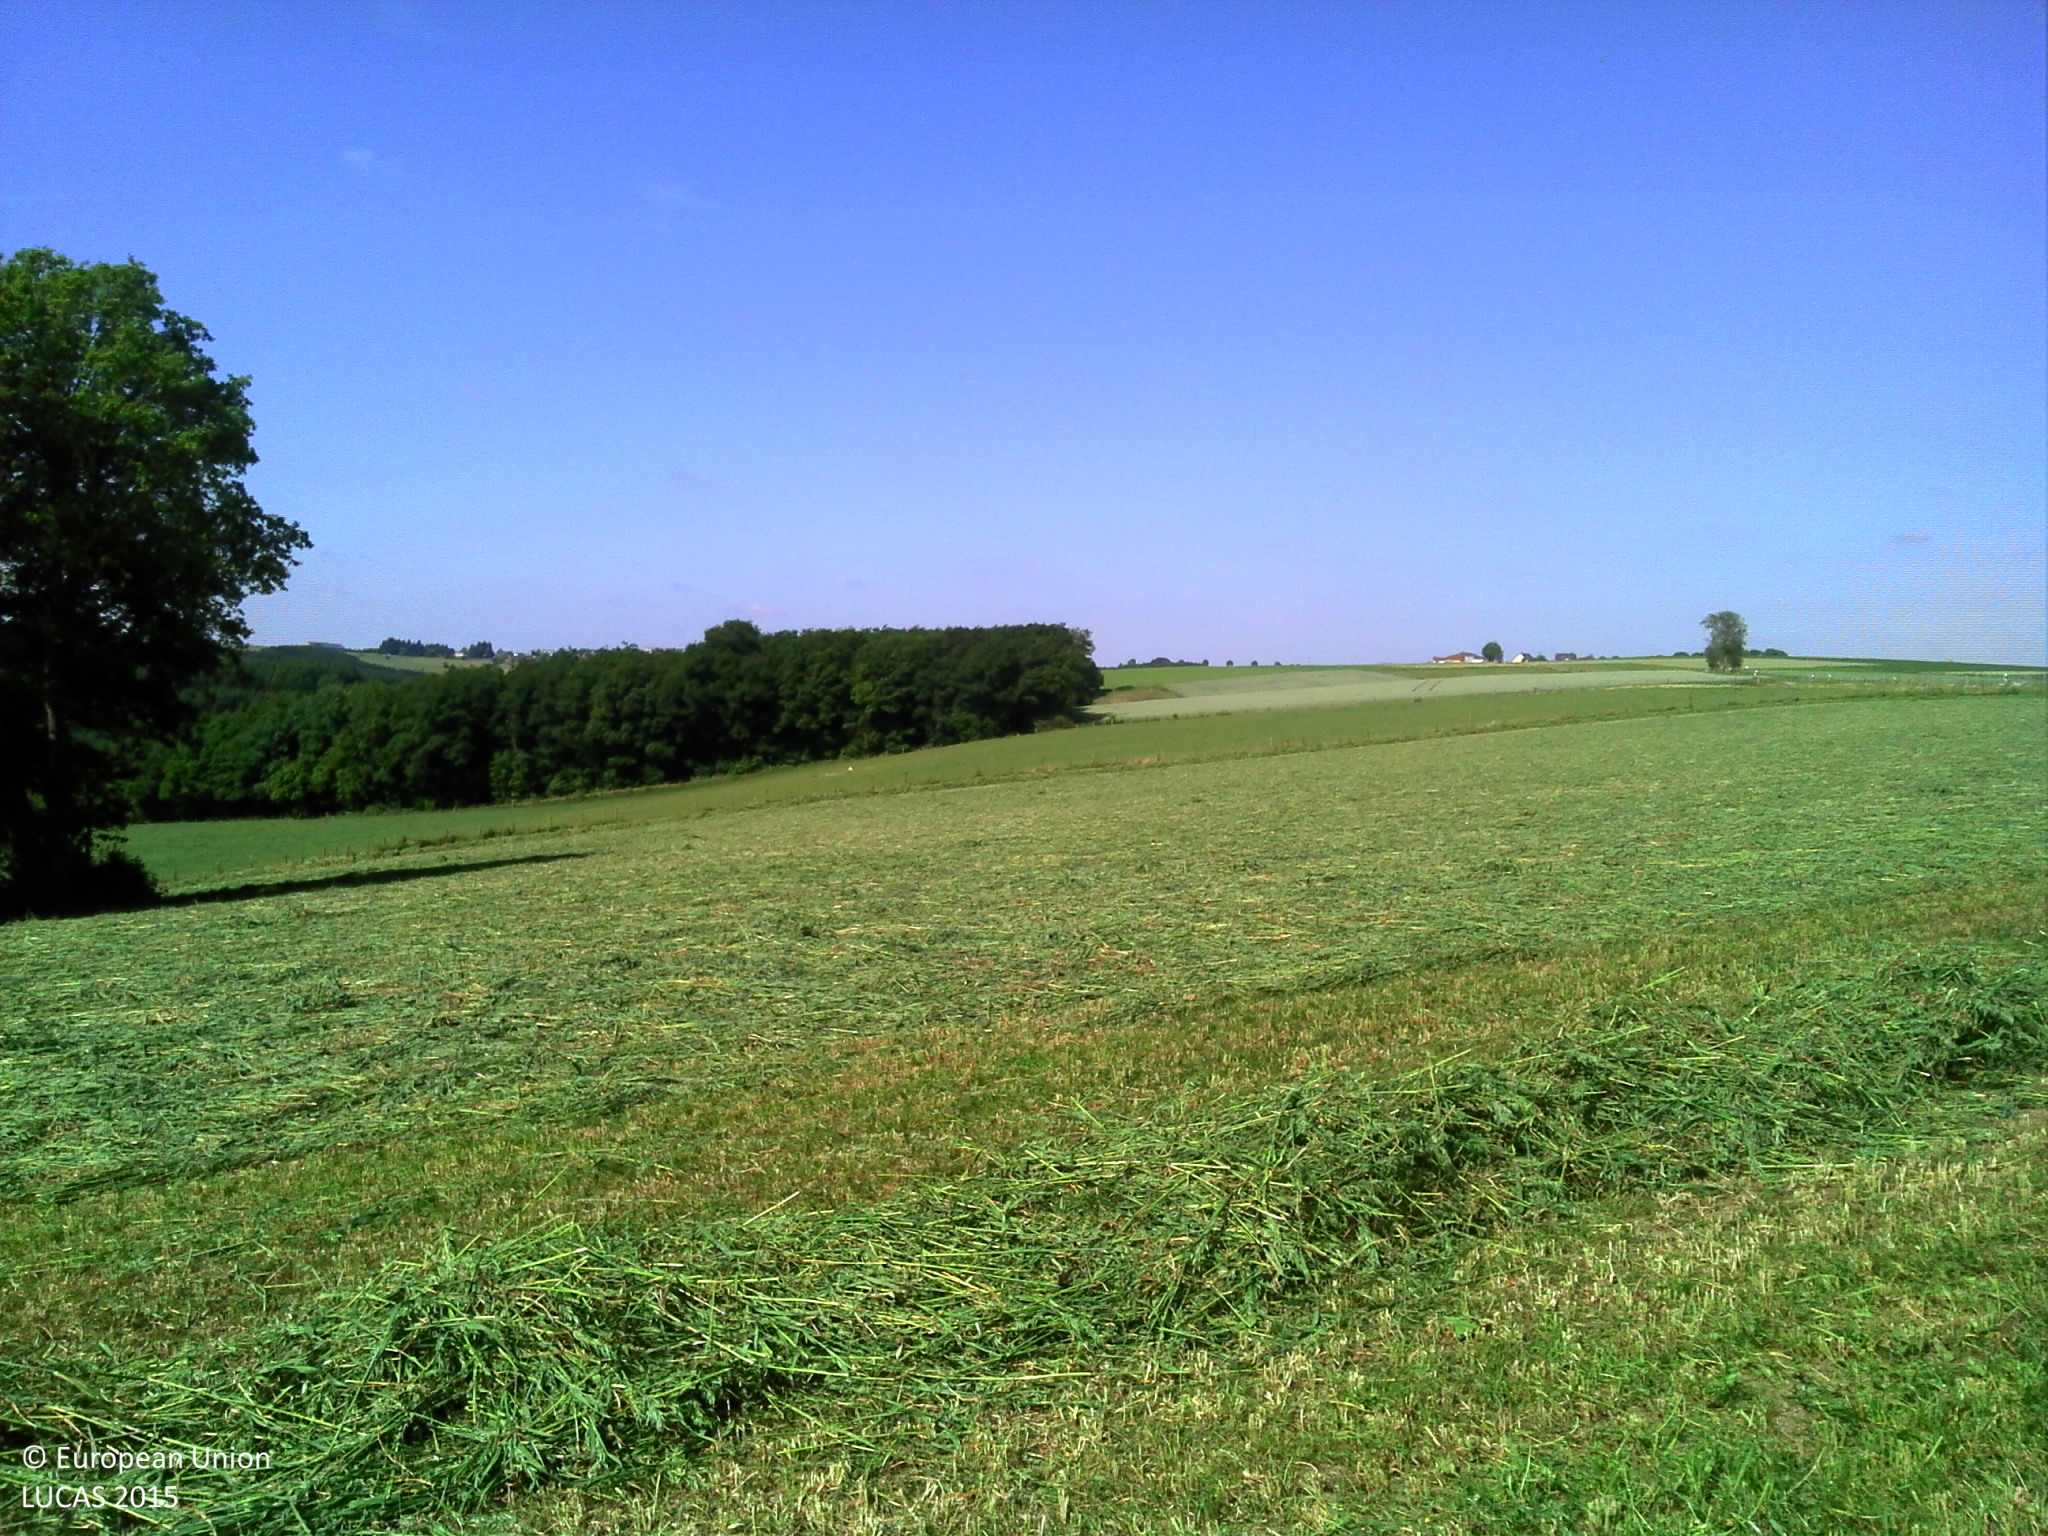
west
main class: Cropland
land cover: Barley
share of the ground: > 75 %
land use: Agriculture (excluding fallow land and kitchen gardens)
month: June
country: LU
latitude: 49.9341
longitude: 6.0007
